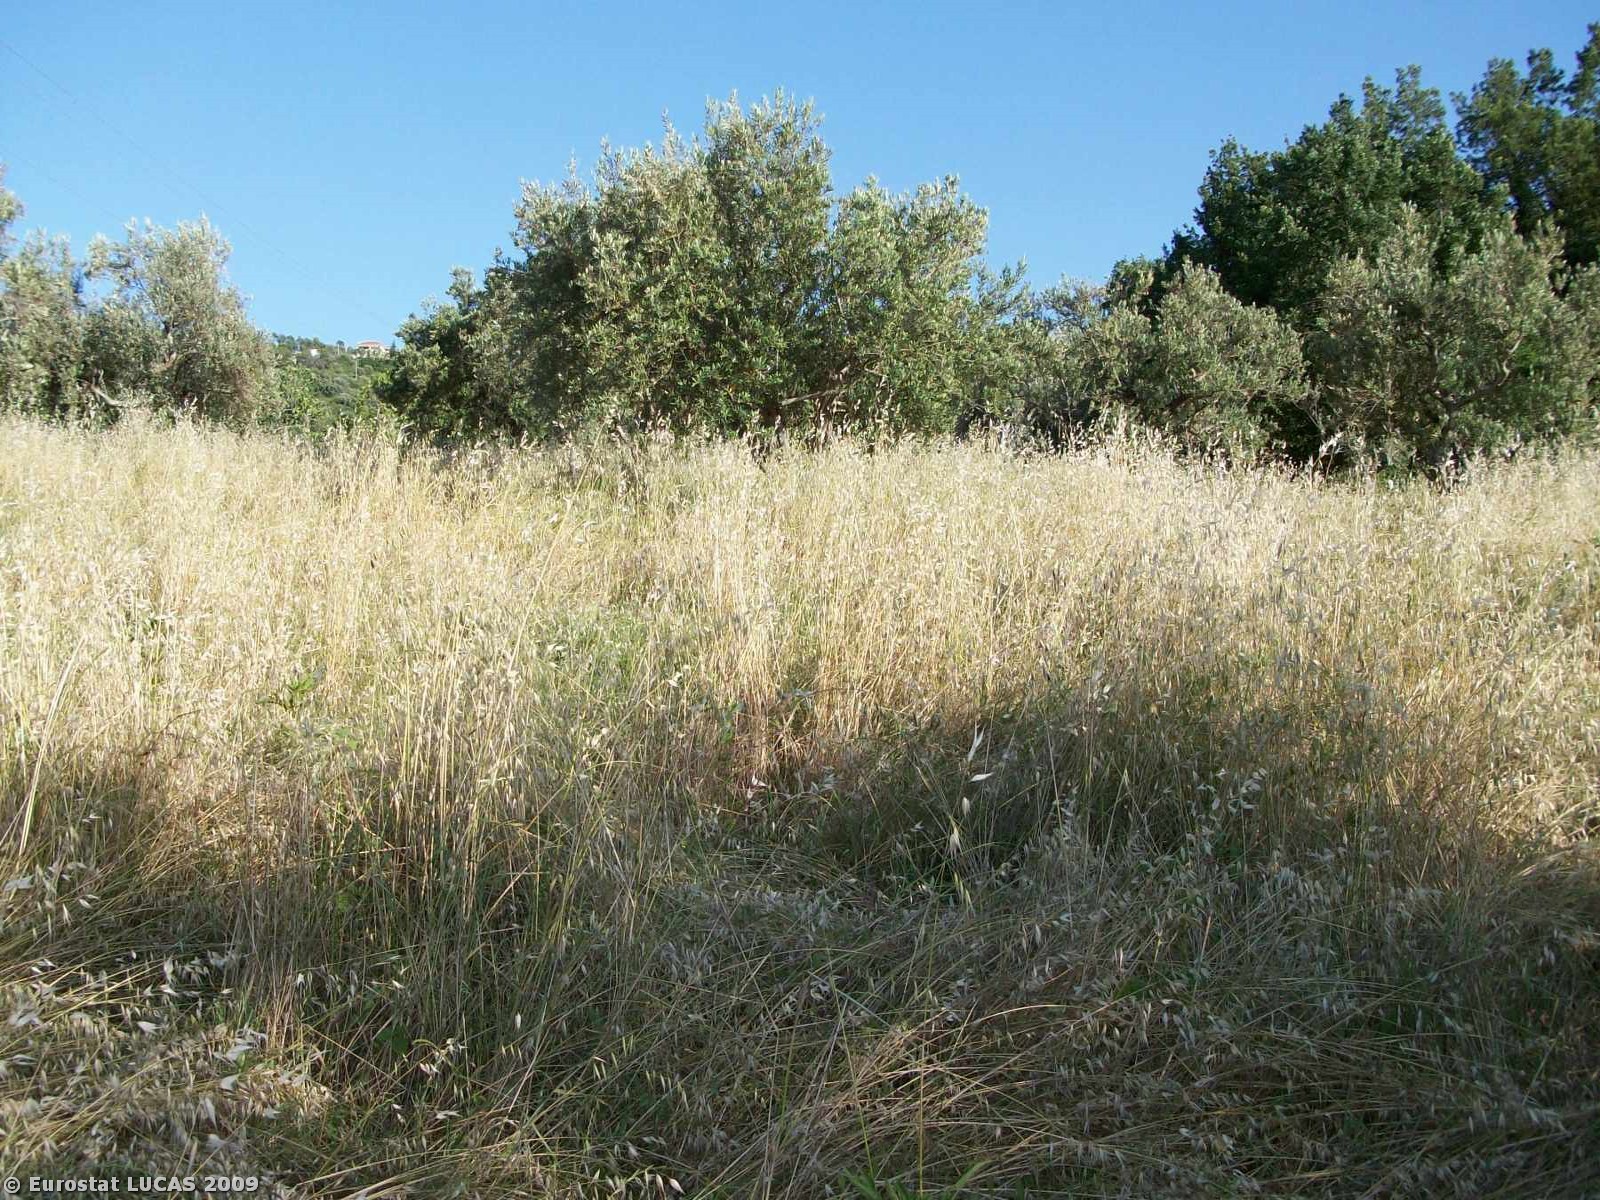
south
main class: Grassland
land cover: Grassland with sparse tree/shrub cover
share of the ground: > 75 %
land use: Fallow land
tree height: < 5 m
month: June
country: IT
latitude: 39.5897
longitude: 16.0613
